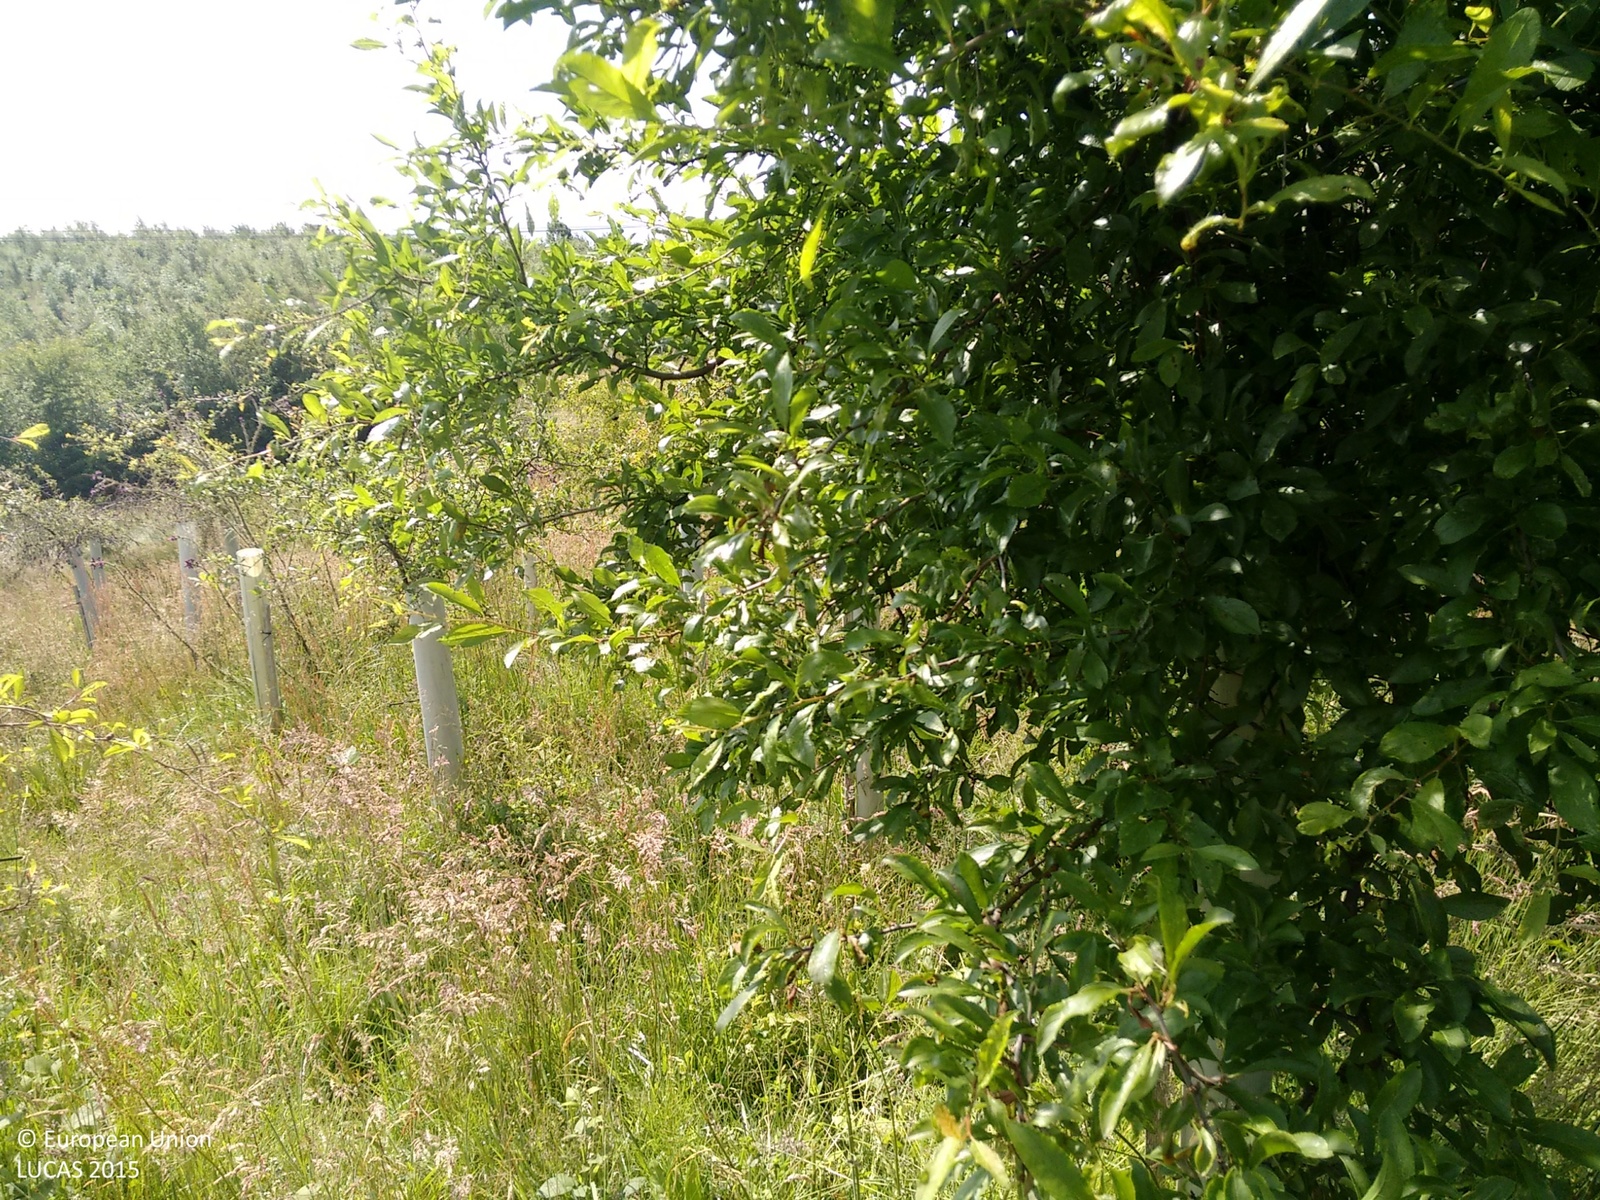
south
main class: Woodland
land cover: Broadleaved woodland
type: mesophytic deciduous forest
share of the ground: 50 - 75 %
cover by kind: broadleaved forest trees 70 %, herbaceous plants 20 %, lichens and mosses 10 %
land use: Forestry
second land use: Amenities, museums, leisure
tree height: < 5 m
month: July
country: GB
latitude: 55.7152
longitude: -4.7330
